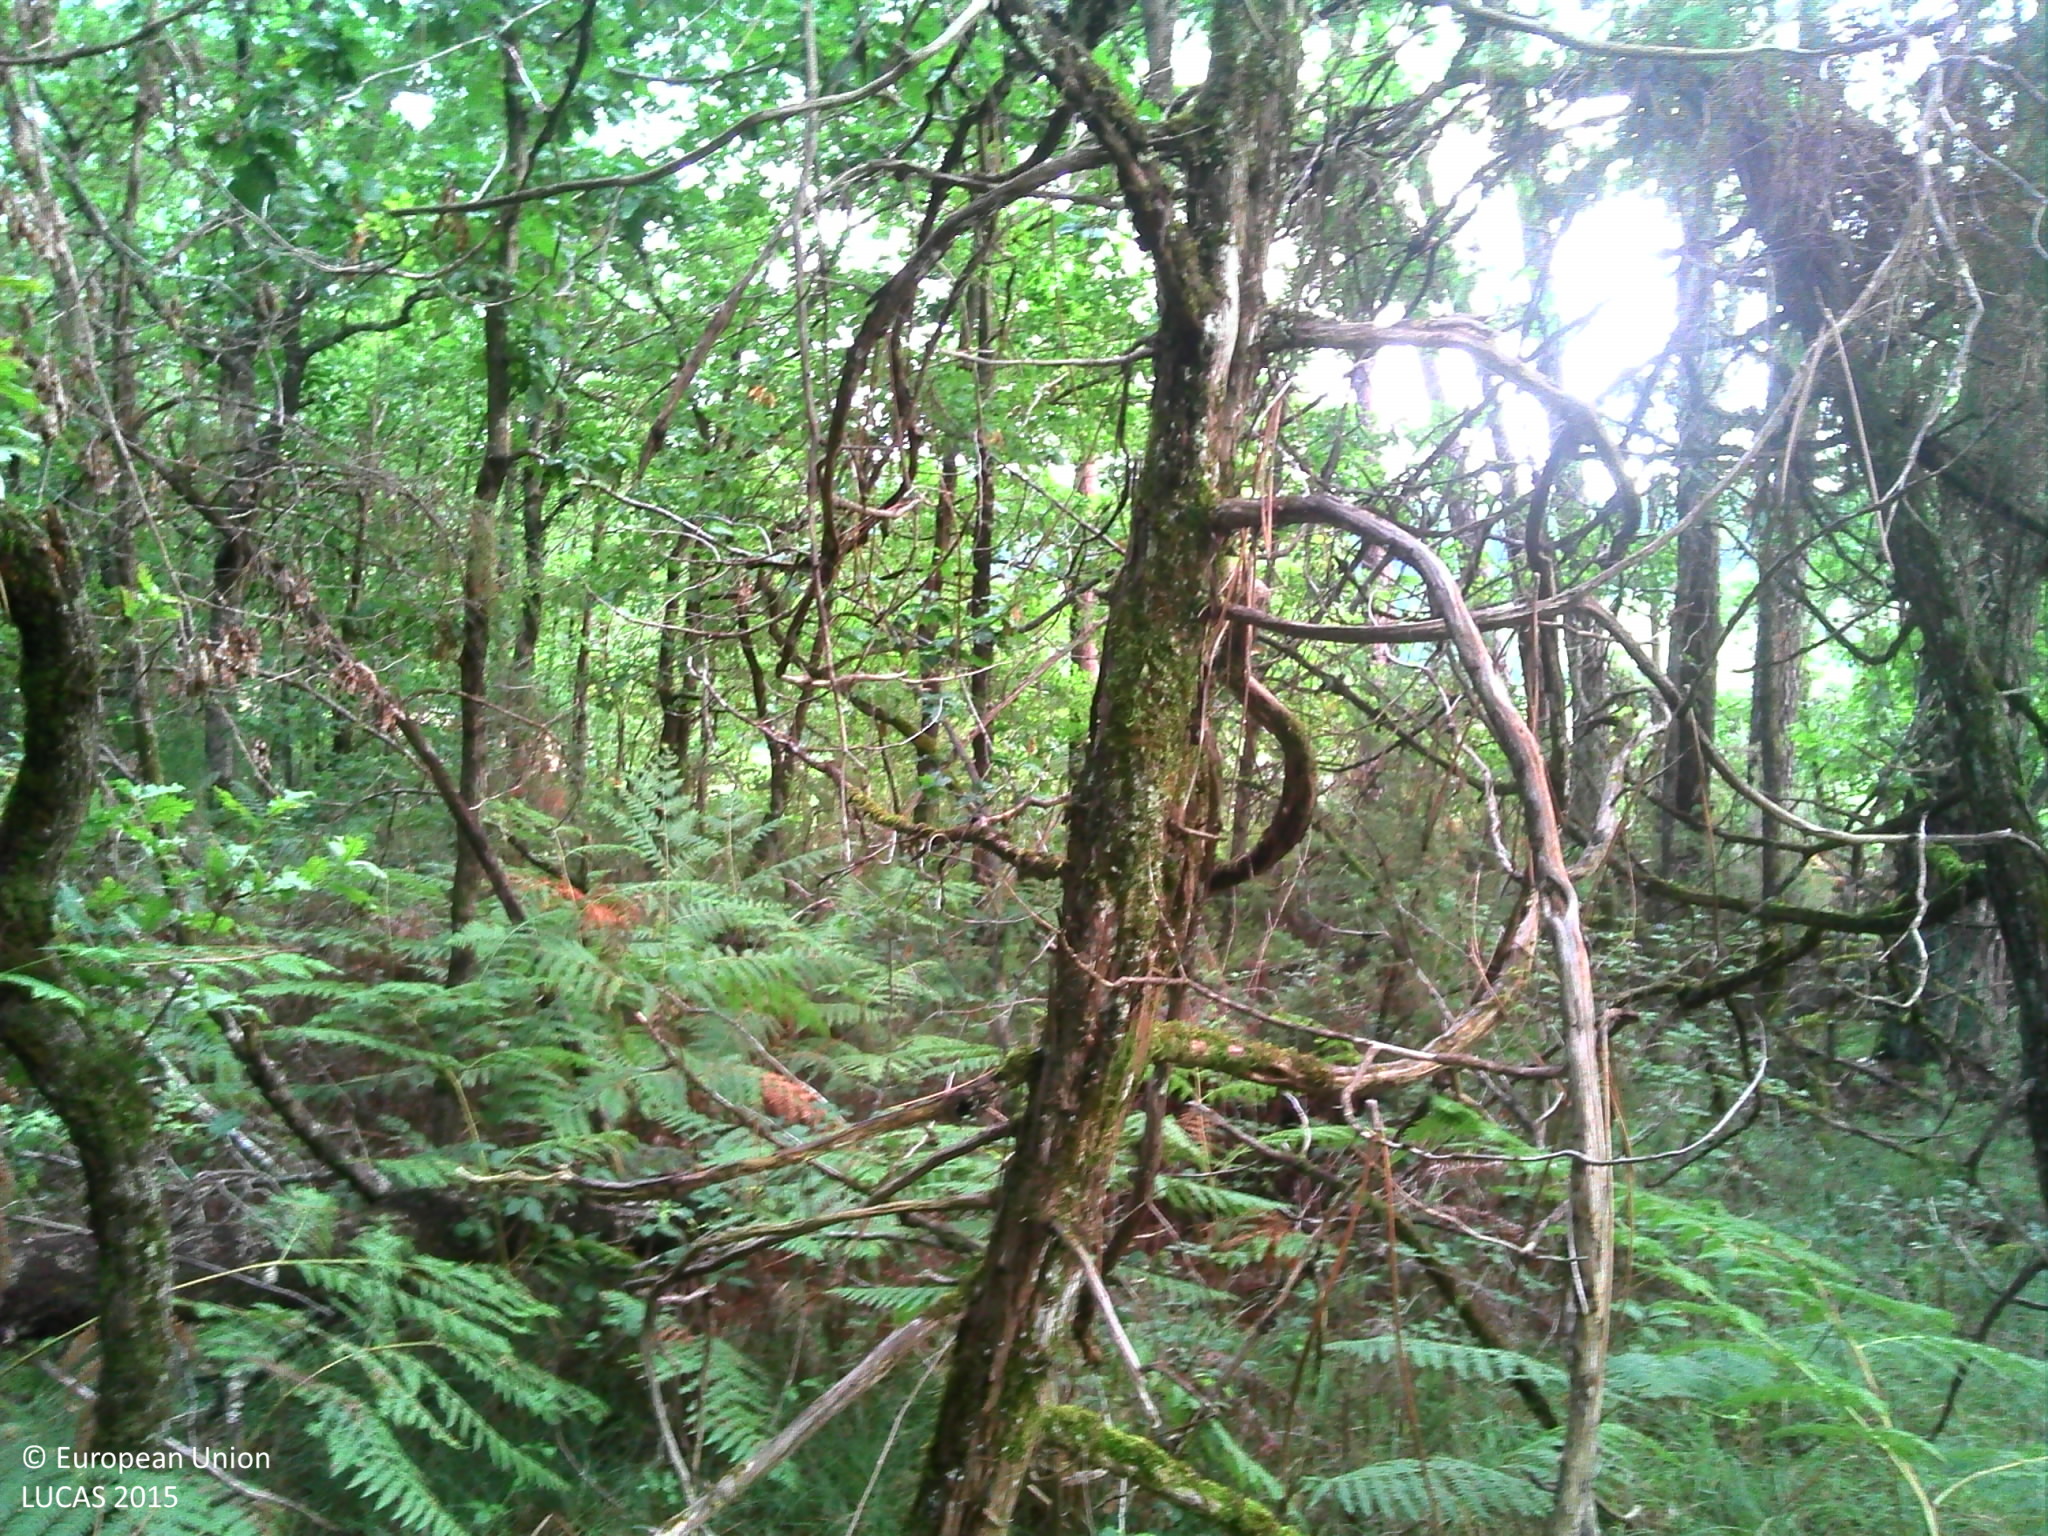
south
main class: Woodland
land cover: Pine dominated mixed woodland
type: thermophilous deciduous forest
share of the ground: > 75 %
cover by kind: broadleaved forest trees 40 %, coniferous forest trees 20 %, herbaceous plants 20 %, lichens and mosses 10 %, consolidated bare surface 10 %
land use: Forestry
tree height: > 5 m
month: August
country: FR
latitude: 45.4395
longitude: 0.7206
